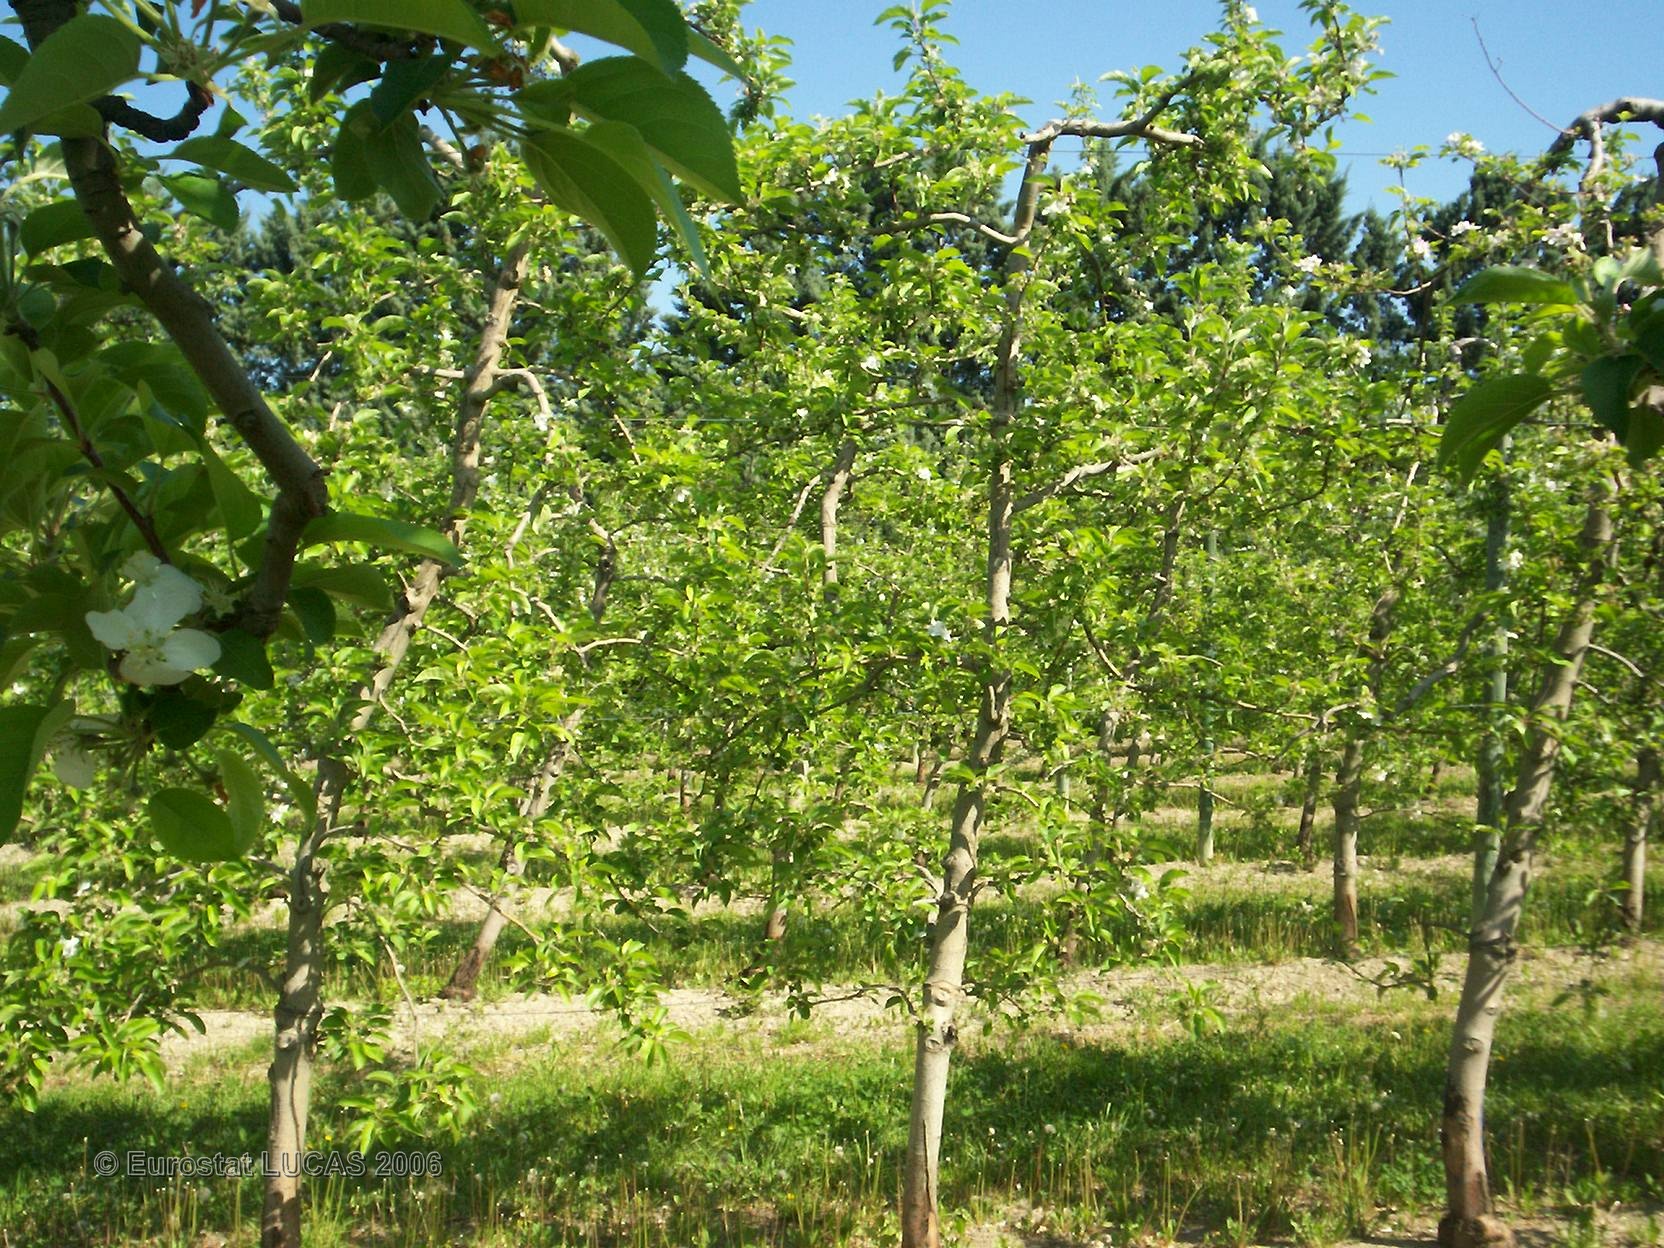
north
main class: Cropland
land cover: Apple fruit
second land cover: Grassland with sparse tree/shrub cover
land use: Agriculture (excluding fallow land and kitchen gardens)
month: April
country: FR
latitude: 43.8864
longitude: 4.9926
